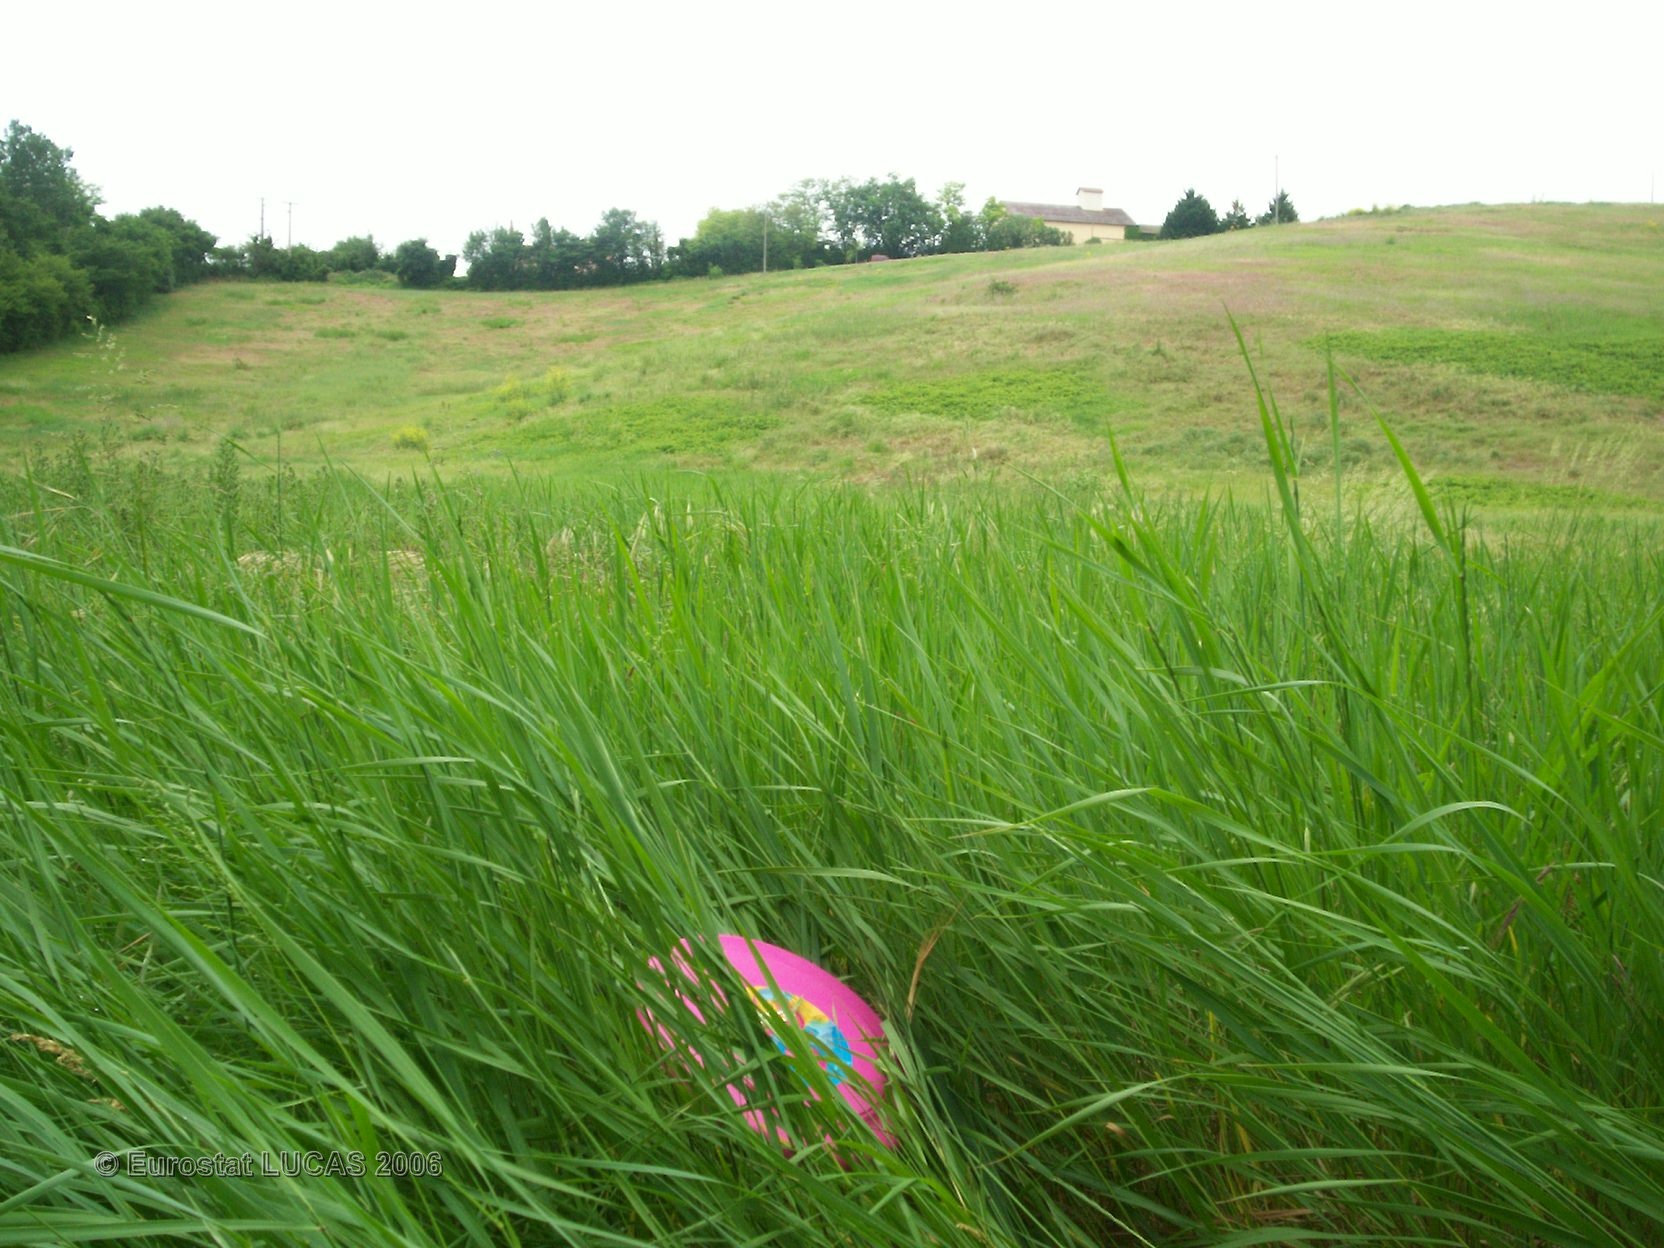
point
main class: Grassland
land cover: Grassland without tree/shrub cover
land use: Agriculture (excluding fallow land and kitchen gardens)
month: May
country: FR
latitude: 43.5282
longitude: 1.0552
